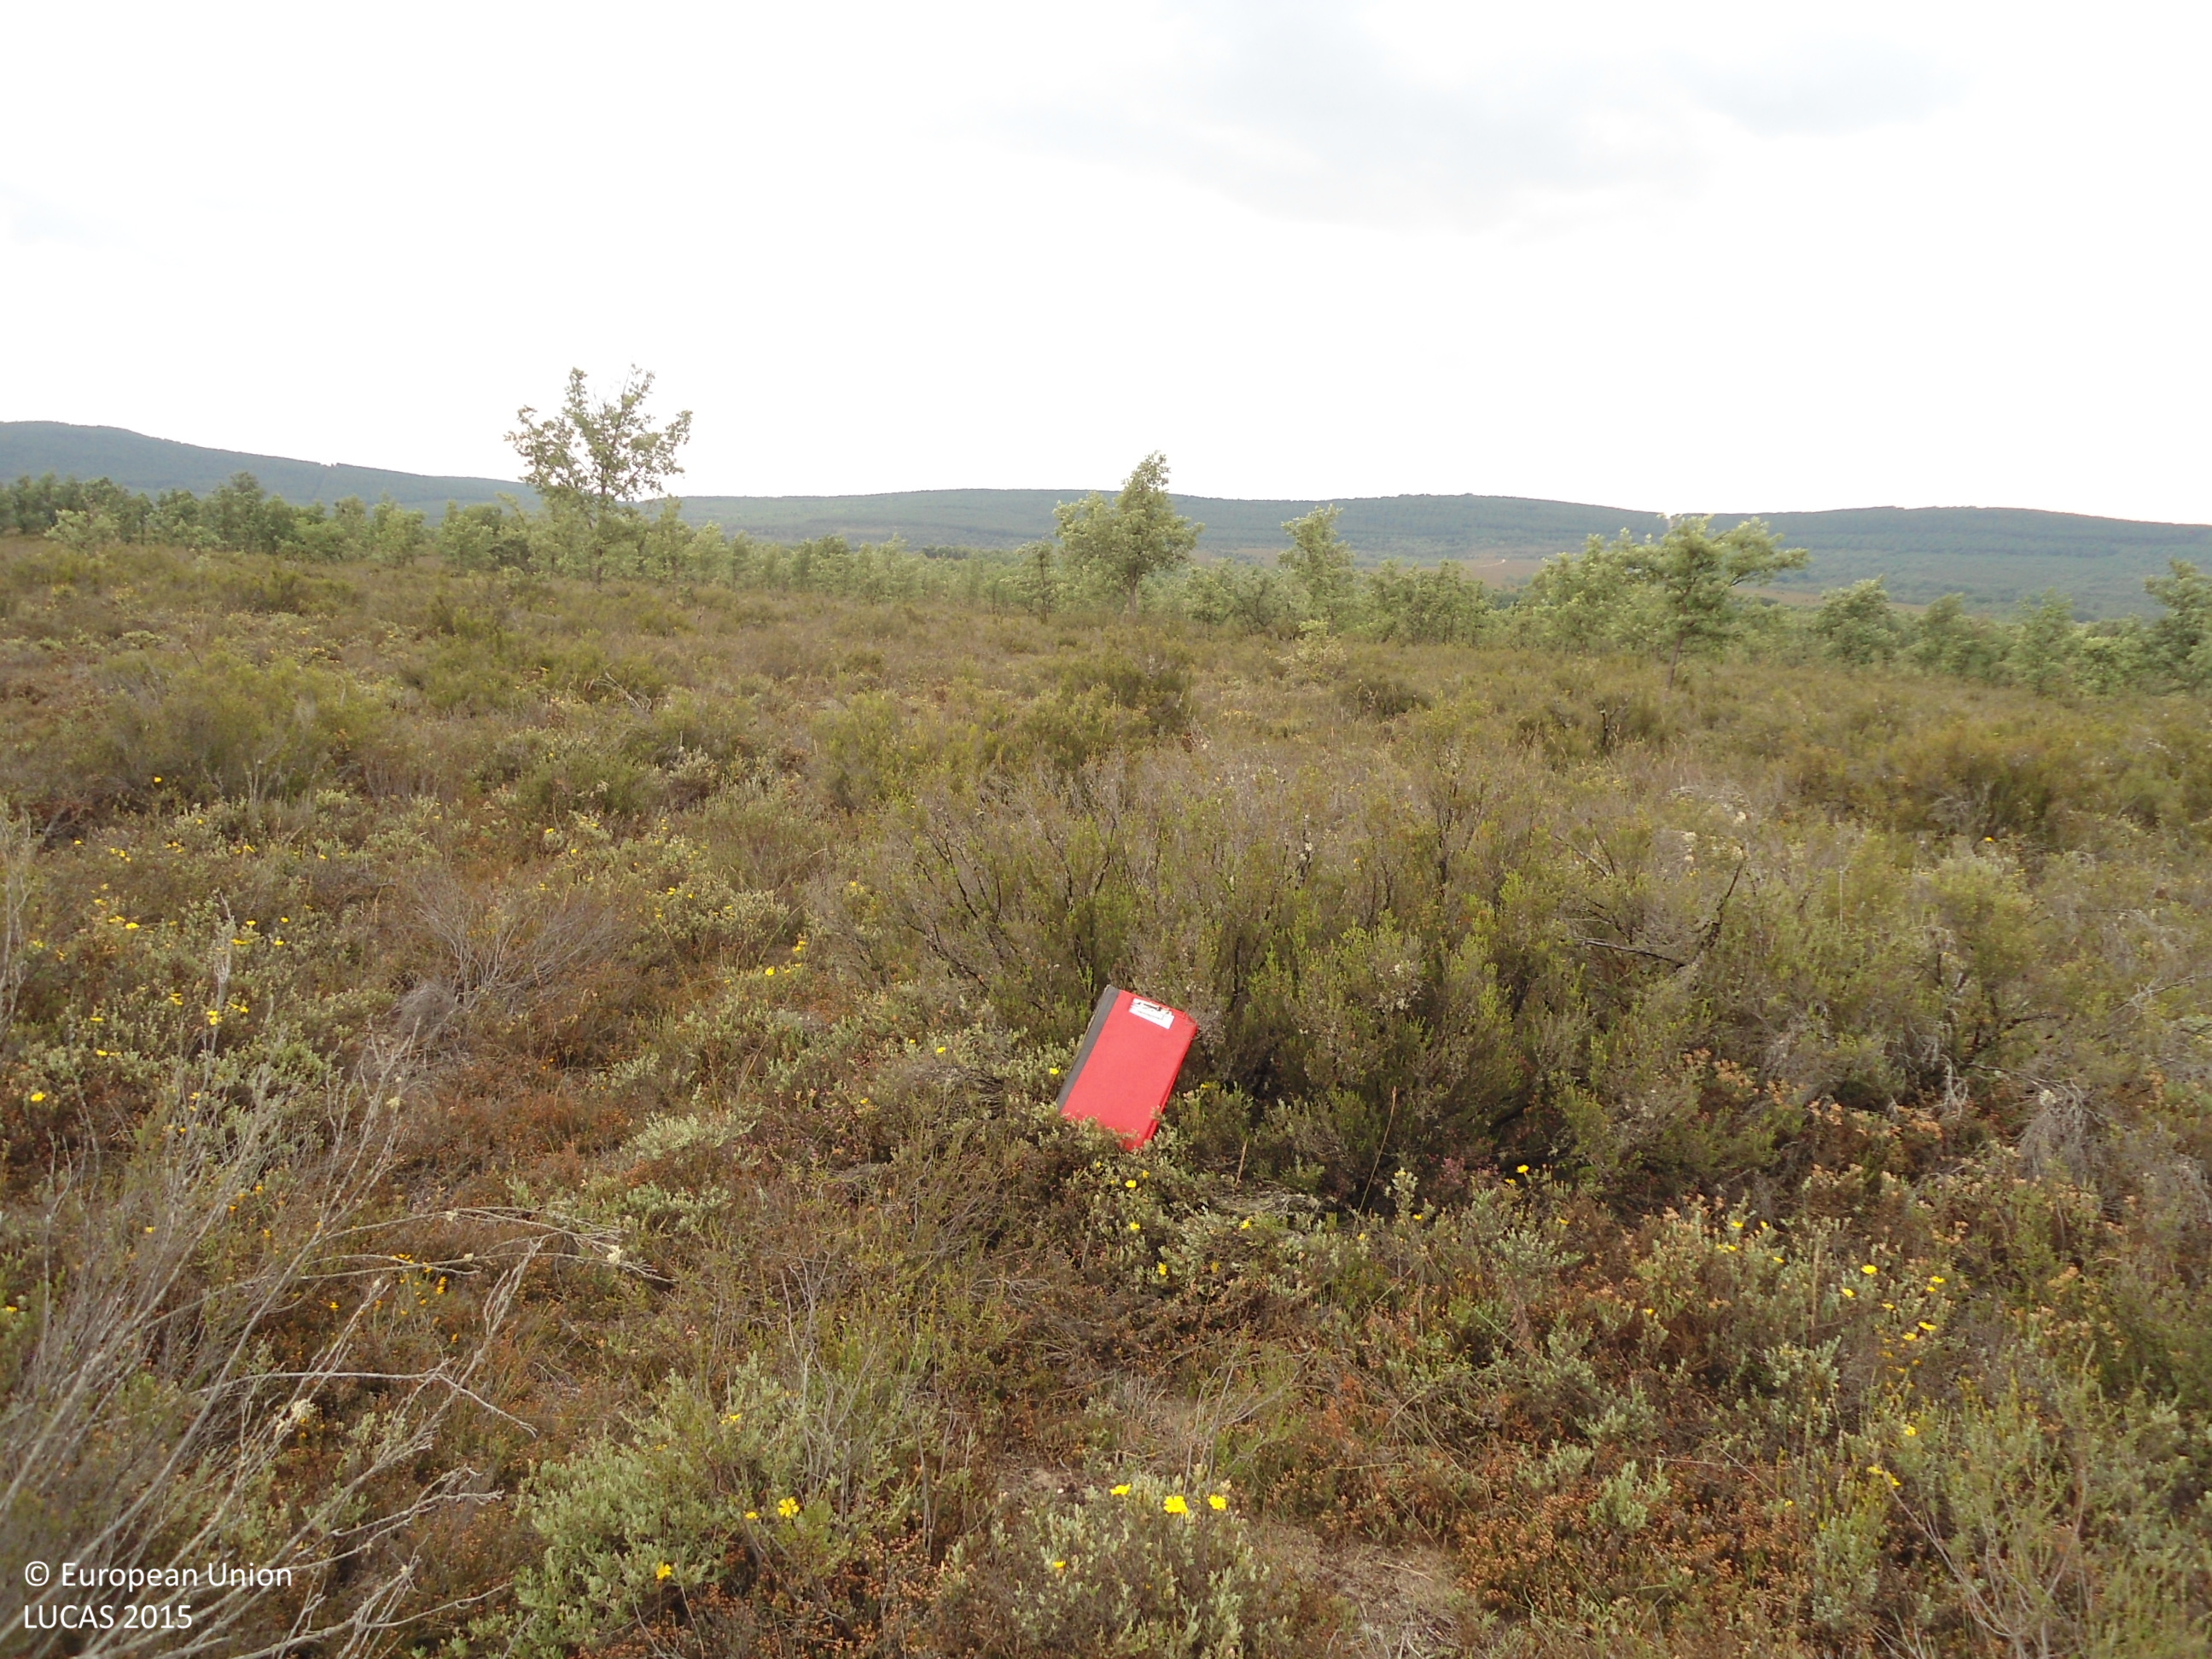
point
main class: Shrubland
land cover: Shrubland with sparse tree cover
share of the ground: > 75 %
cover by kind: shrubs 95 %, broadleaved forest trees 5 %
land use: Semi-natural and natural areas not in use
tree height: < 5 m
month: June
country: ES
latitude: 41.9455
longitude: -6.2058
